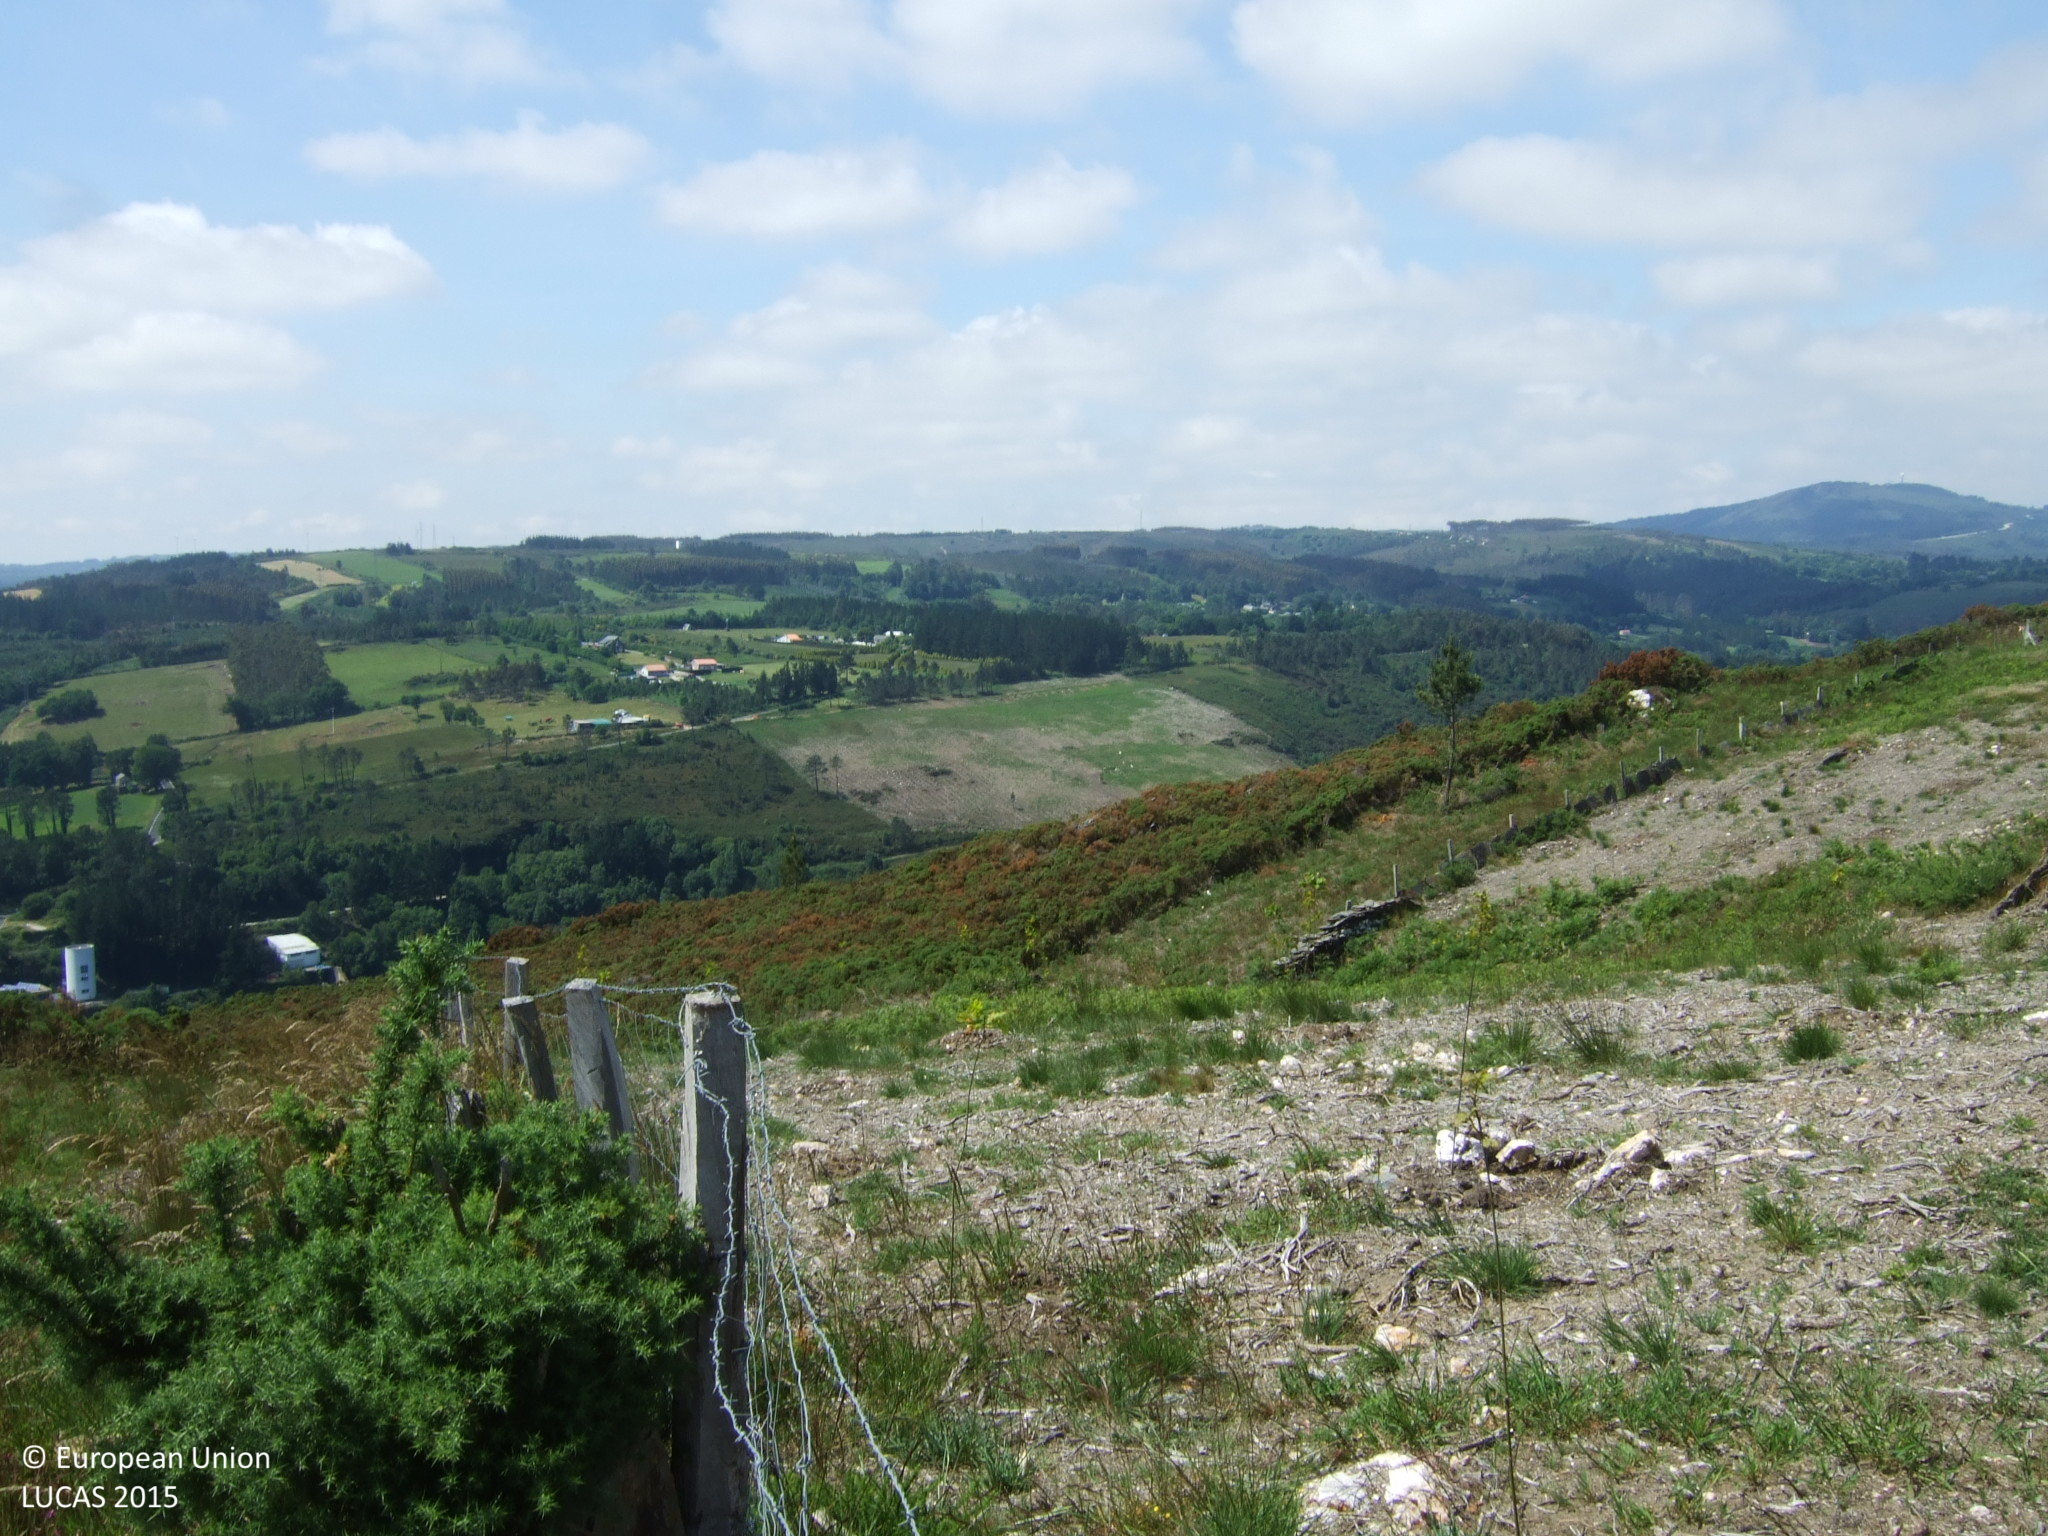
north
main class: Grassland
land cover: Grassland with sparse tree/shrub cover
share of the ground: 50 - 75 %
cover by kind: herbaceous plants 60 %, unconsolidated bare surface 25 %, shrubs 10 %, broadleaved forest trees 5 %
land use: Forestry
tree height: < 5 m
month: June
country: ES
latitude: 43.4557
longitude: -7.8247
